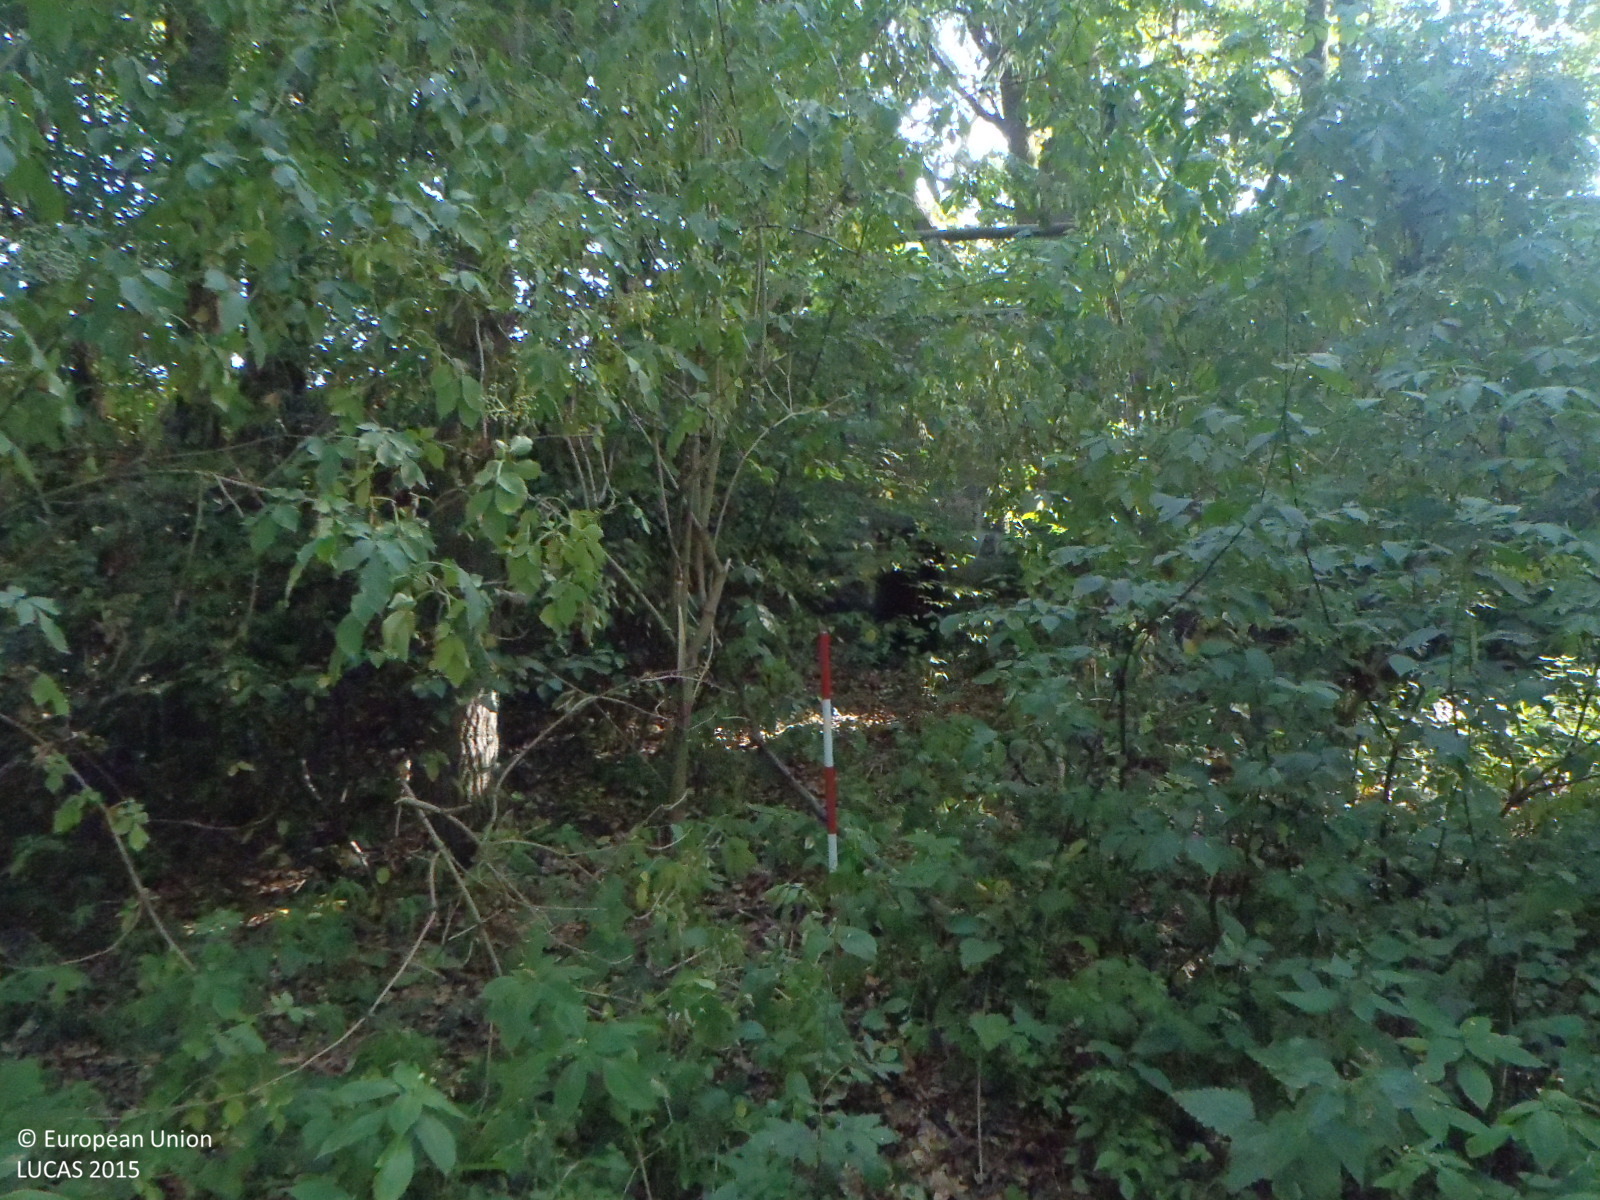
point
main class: Woodland
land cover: Broadleaved woodland
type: mesophytic deciduous forest
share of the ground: > 75 %
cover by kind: broadleaved forest trees 95 %, herbaceous plants 5 %
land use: Forestry
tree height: > 5 m
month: August
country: CZ
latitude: 50.7070
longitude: 14.5191
